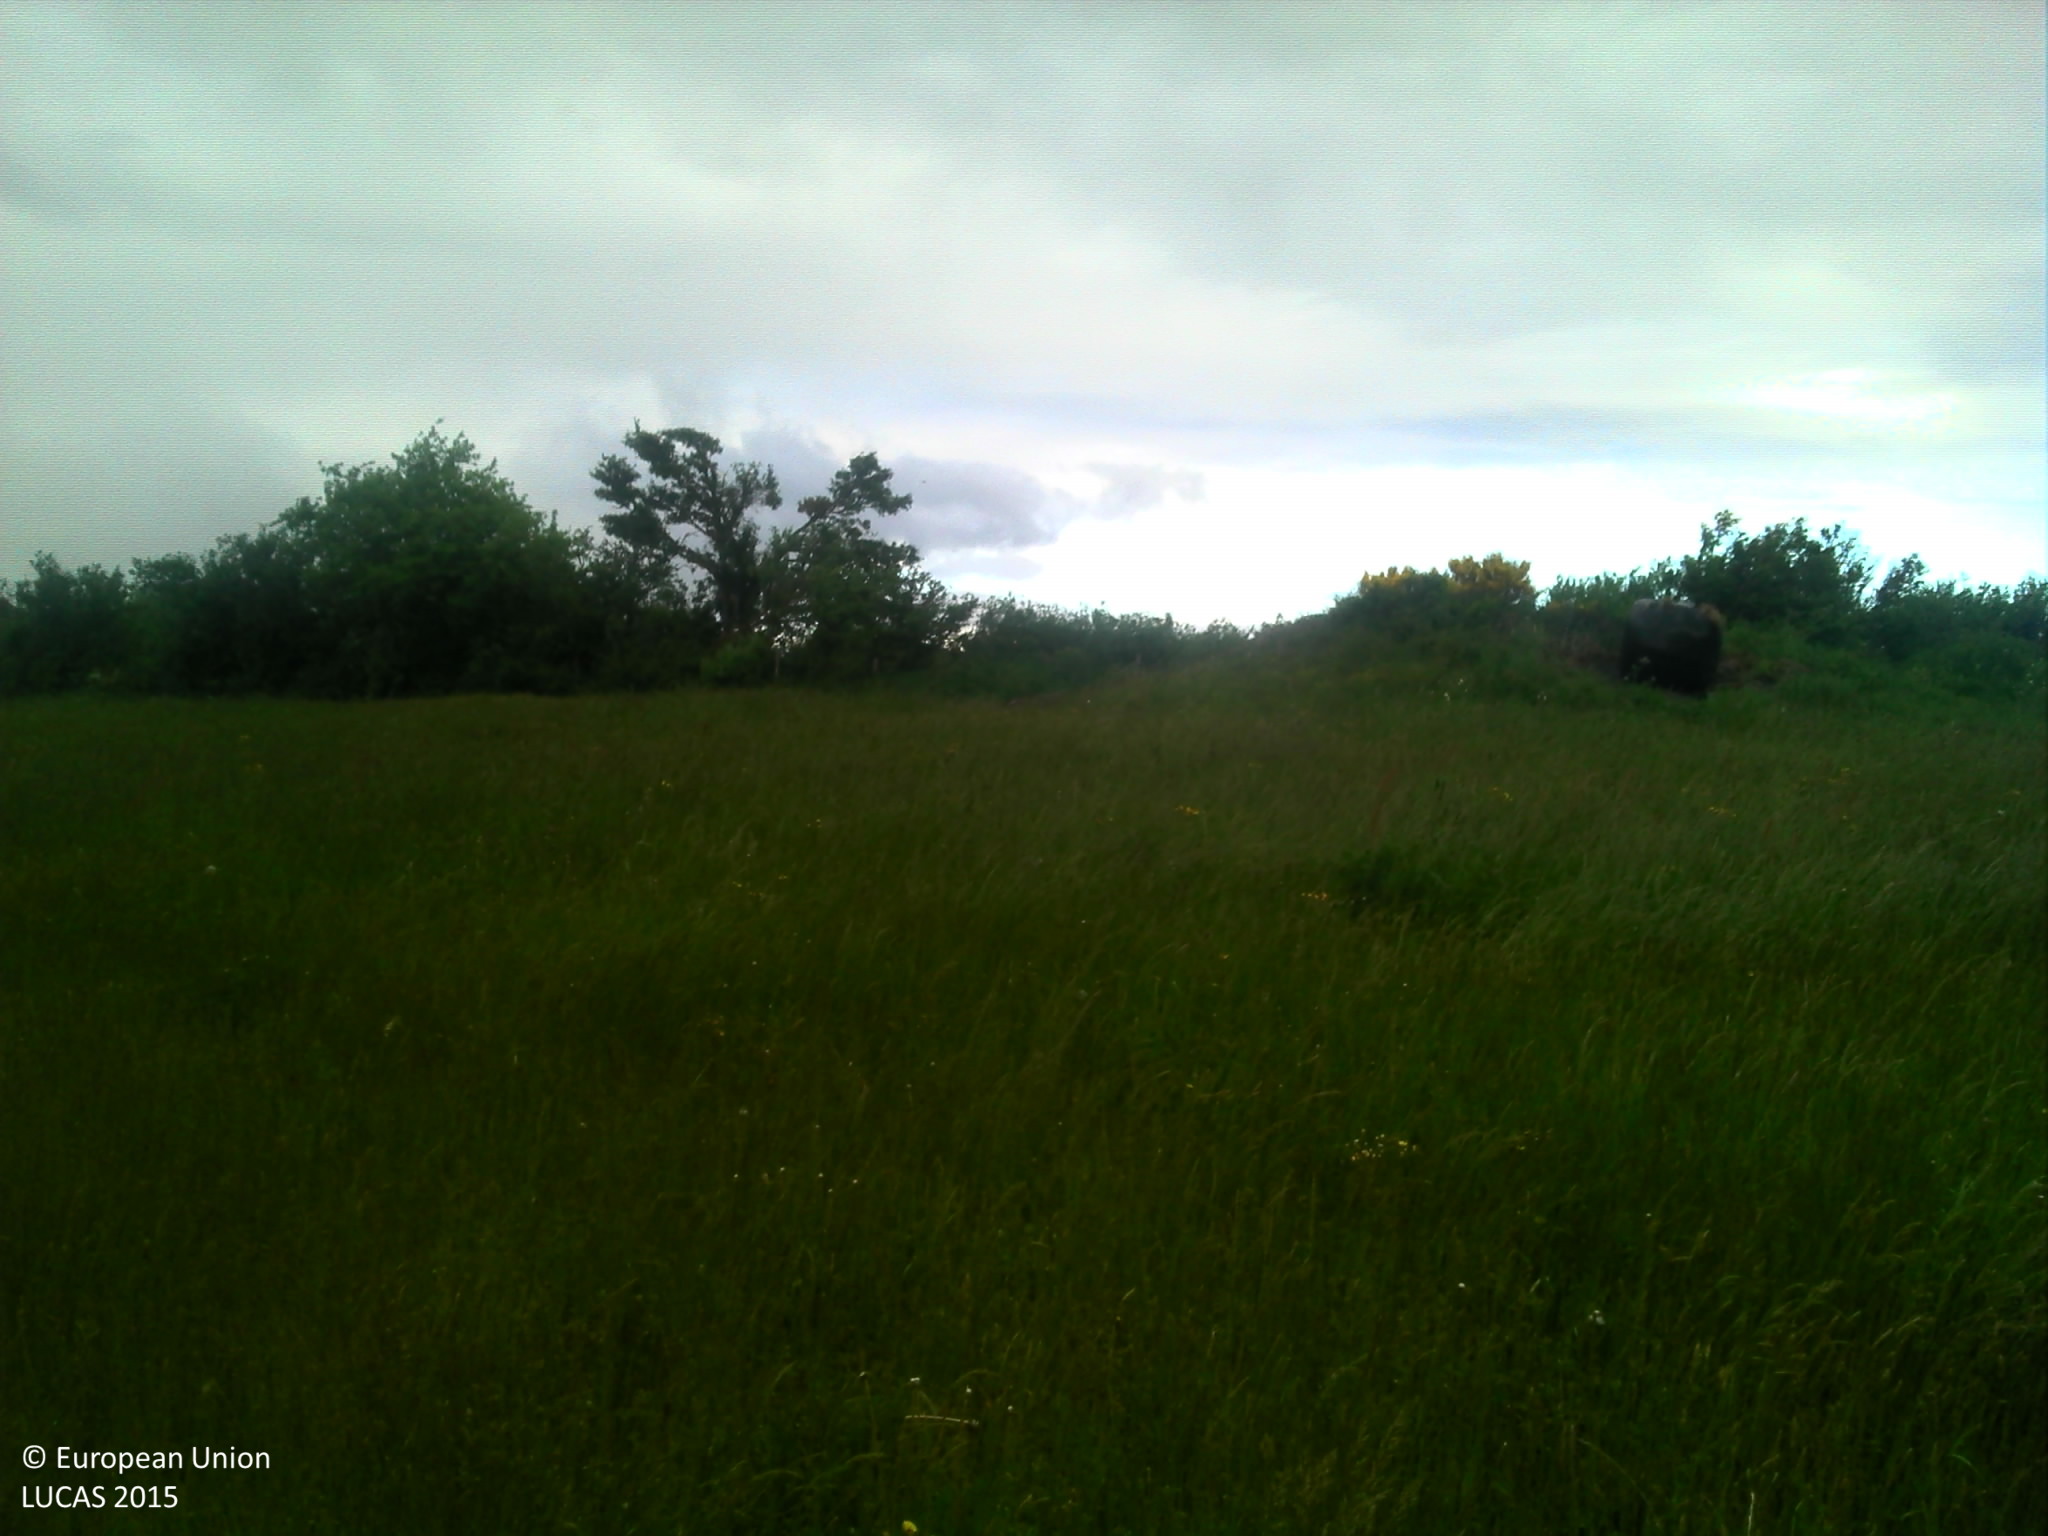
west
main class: Grassland
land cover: Grassland without tree/shrub cover
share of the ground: > 75 %
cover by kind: herbaceous plants 100 %
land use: Agriculture (excluding fallow land and kitchen gardens)
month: June
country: FR
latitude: 45.1778
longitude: 3.2196
